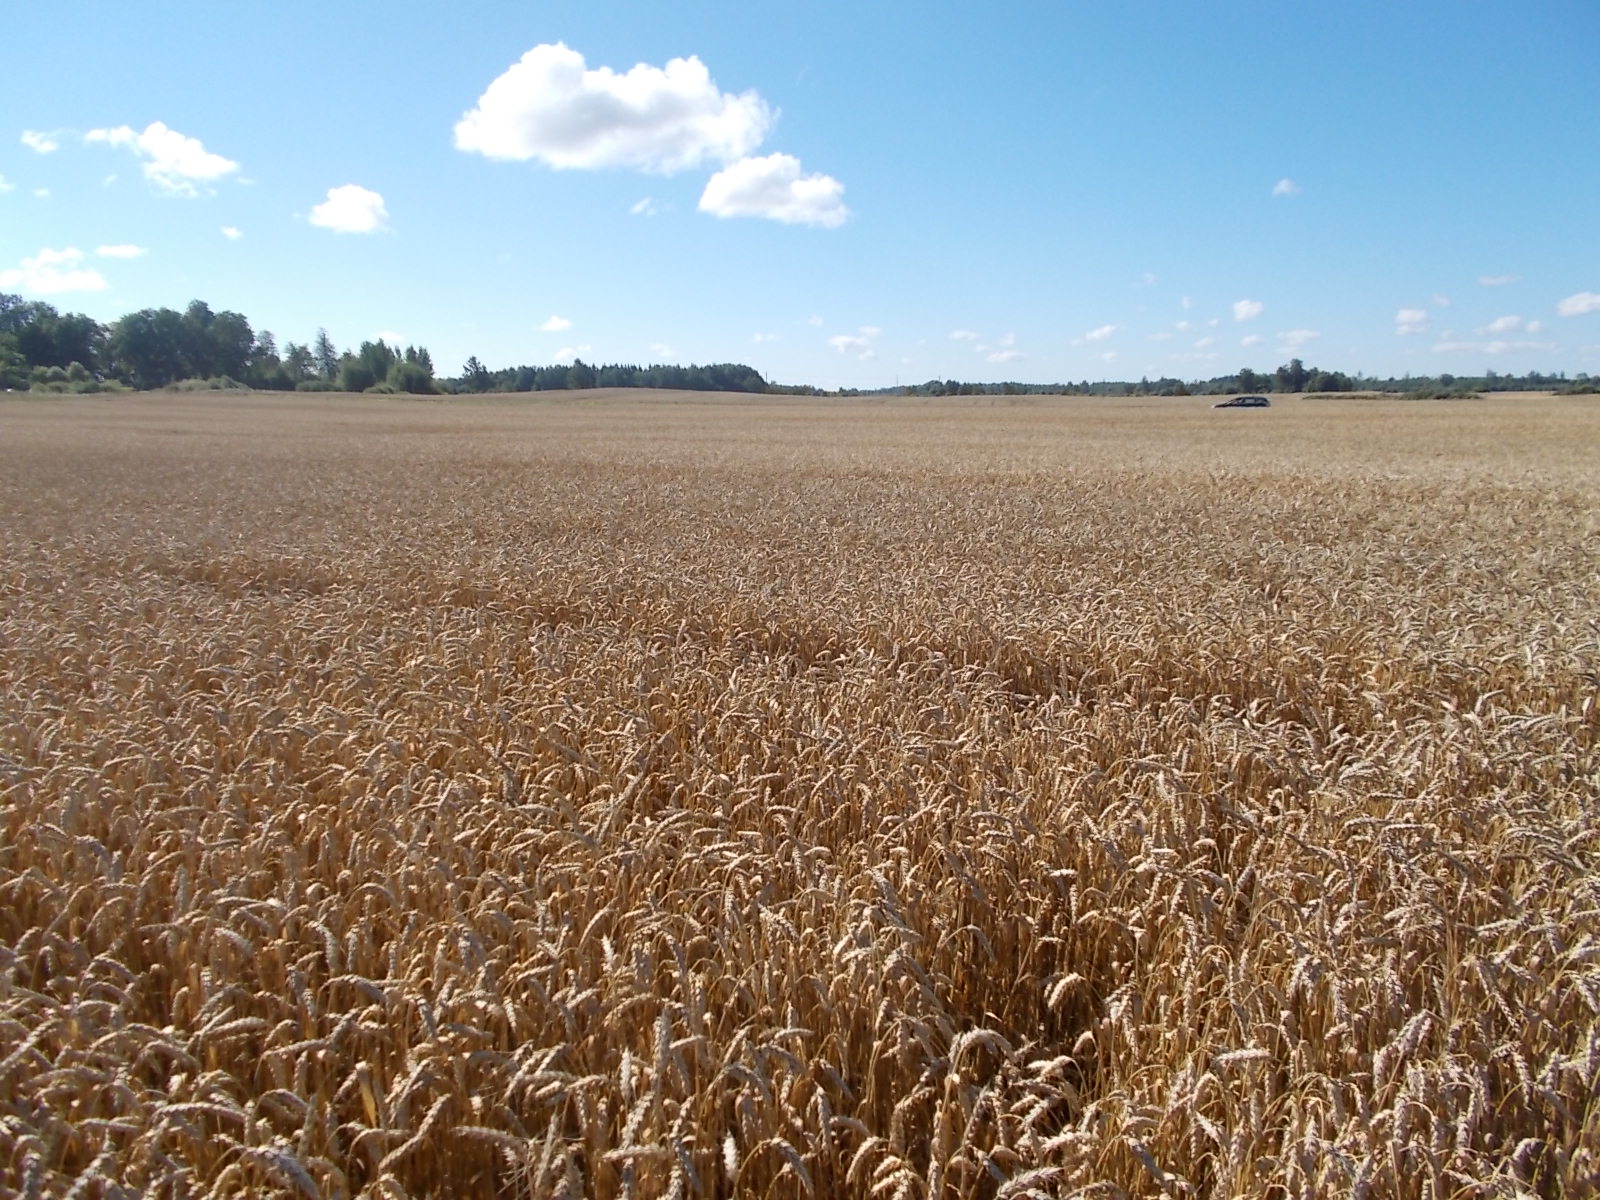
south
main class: Cropland
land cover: Common wheat
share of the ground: > 75 %
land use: Agriculture (excluding fallow land and kitchen gardens)
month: August
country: LV
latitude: 56.8992
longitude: 22.9181
